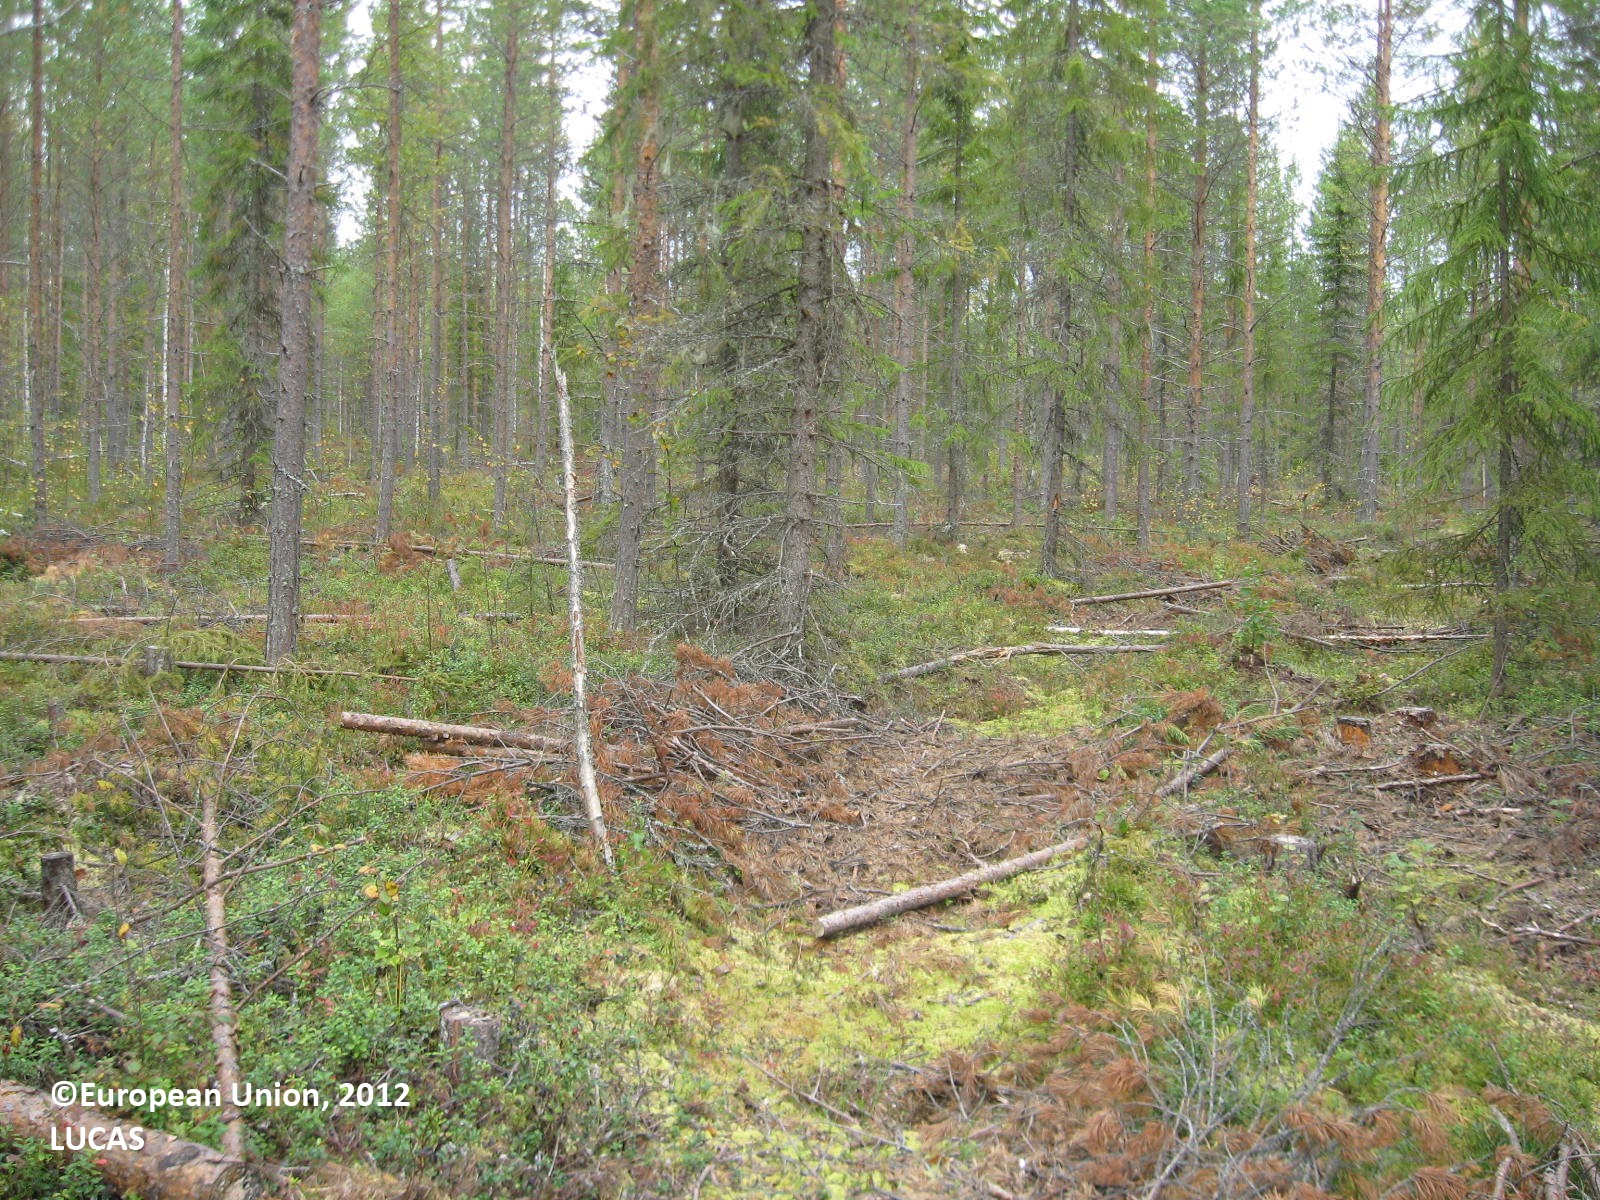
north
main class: Woodland
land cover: Pine dominated coniferous woodland
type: boreal forest
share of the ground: > 75 %
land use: Forestry
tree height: > 5 m
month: September
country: FI
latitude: 64.0809
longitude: 28.3226
